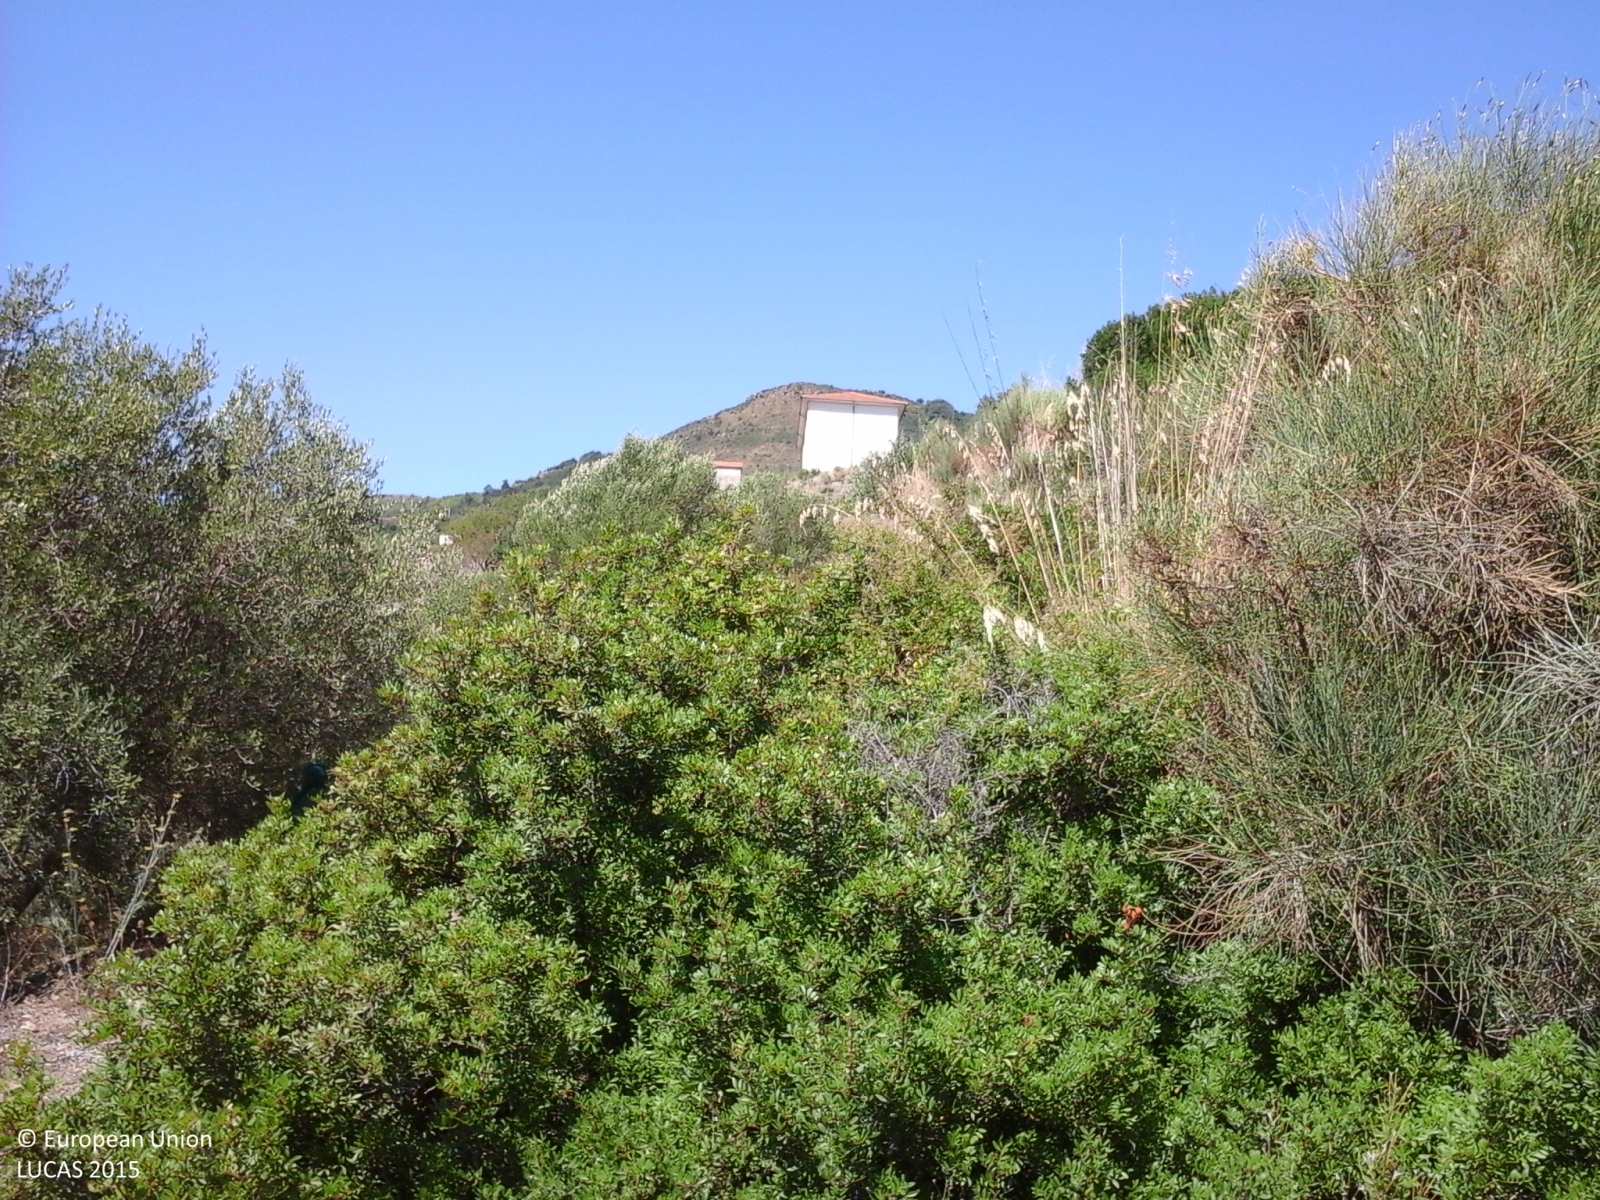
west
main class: Shrubland
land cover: Shrubland with sparse tree cover
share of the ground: > 75 %
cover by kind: shrubs 80 %, herbaceous plants 15 %, broadleaved forest trees 5 %
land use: Semi-natural and natural areas not in use
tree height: < 5 m
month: August
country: IT
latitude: 40.2259
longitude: 15.0894
